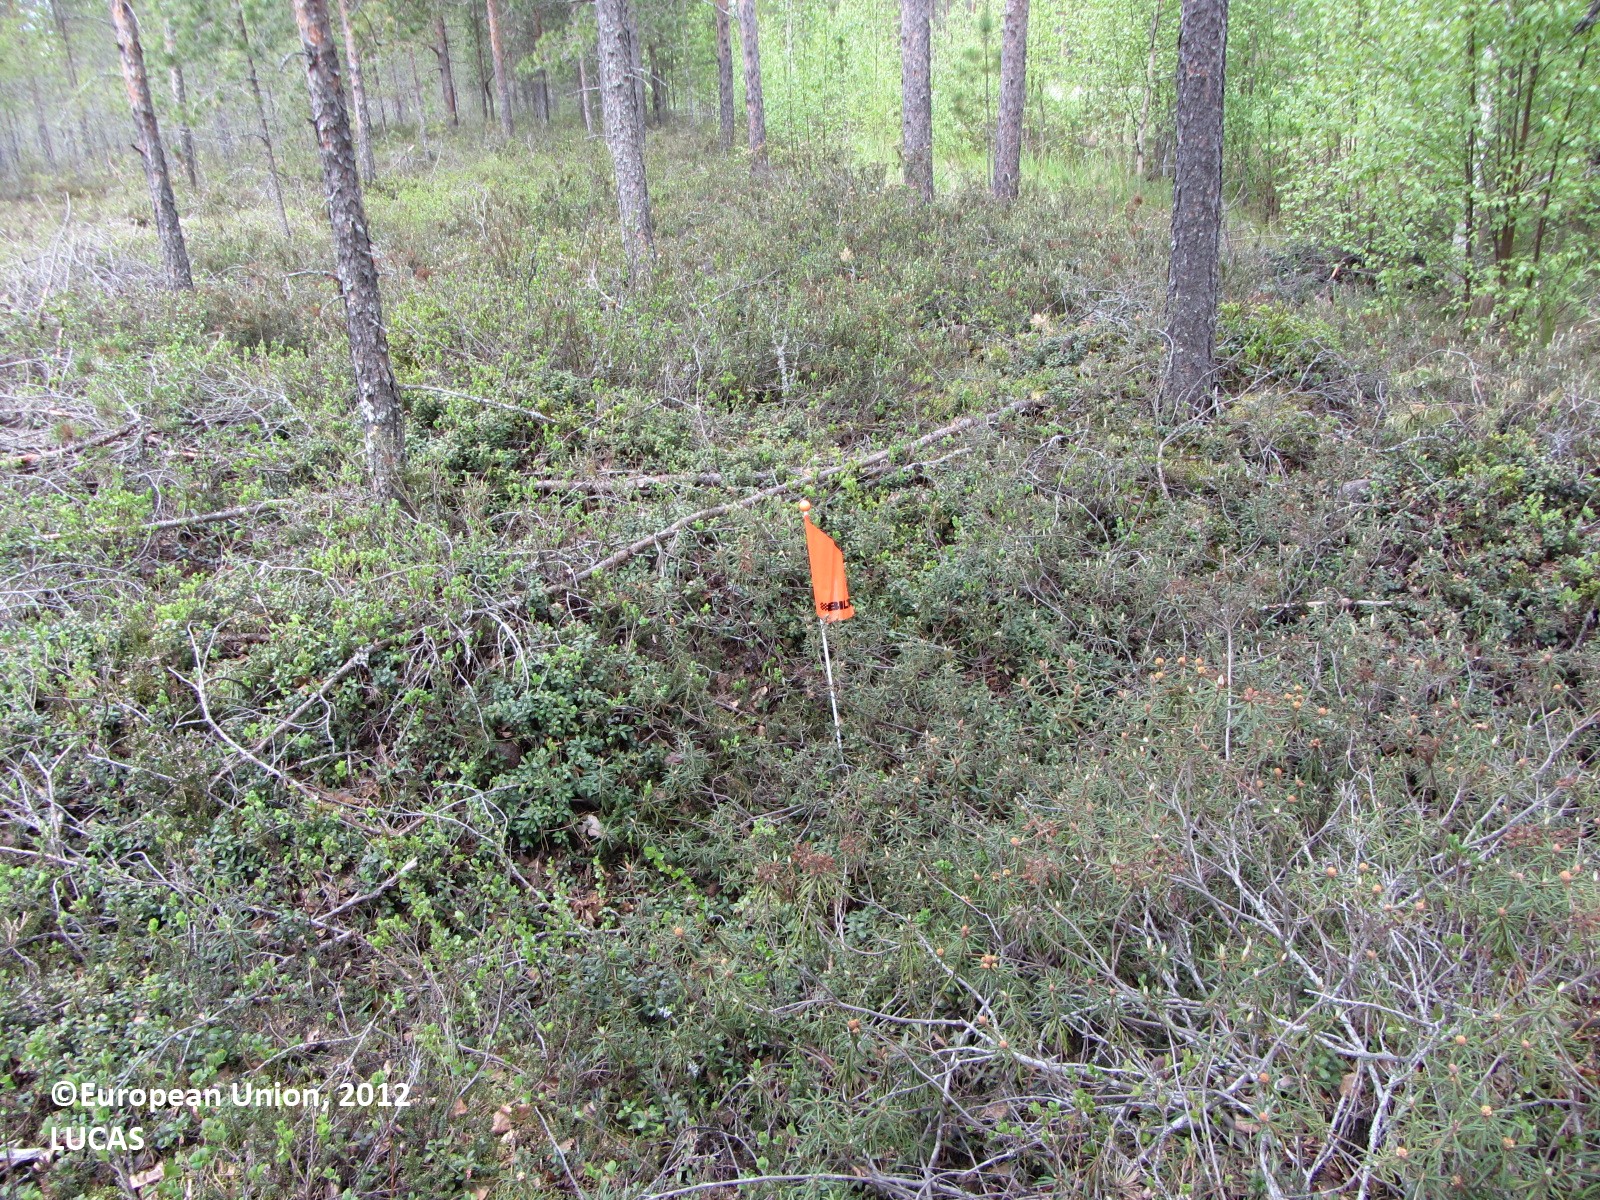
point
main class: Woodland
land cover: Pine dominated coniferous woodland
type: boreal forest
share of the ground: 50 - 75 %
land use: Forestry
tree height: > 5 m
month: June
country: FI
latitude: 63.8027
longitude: 24.6780
